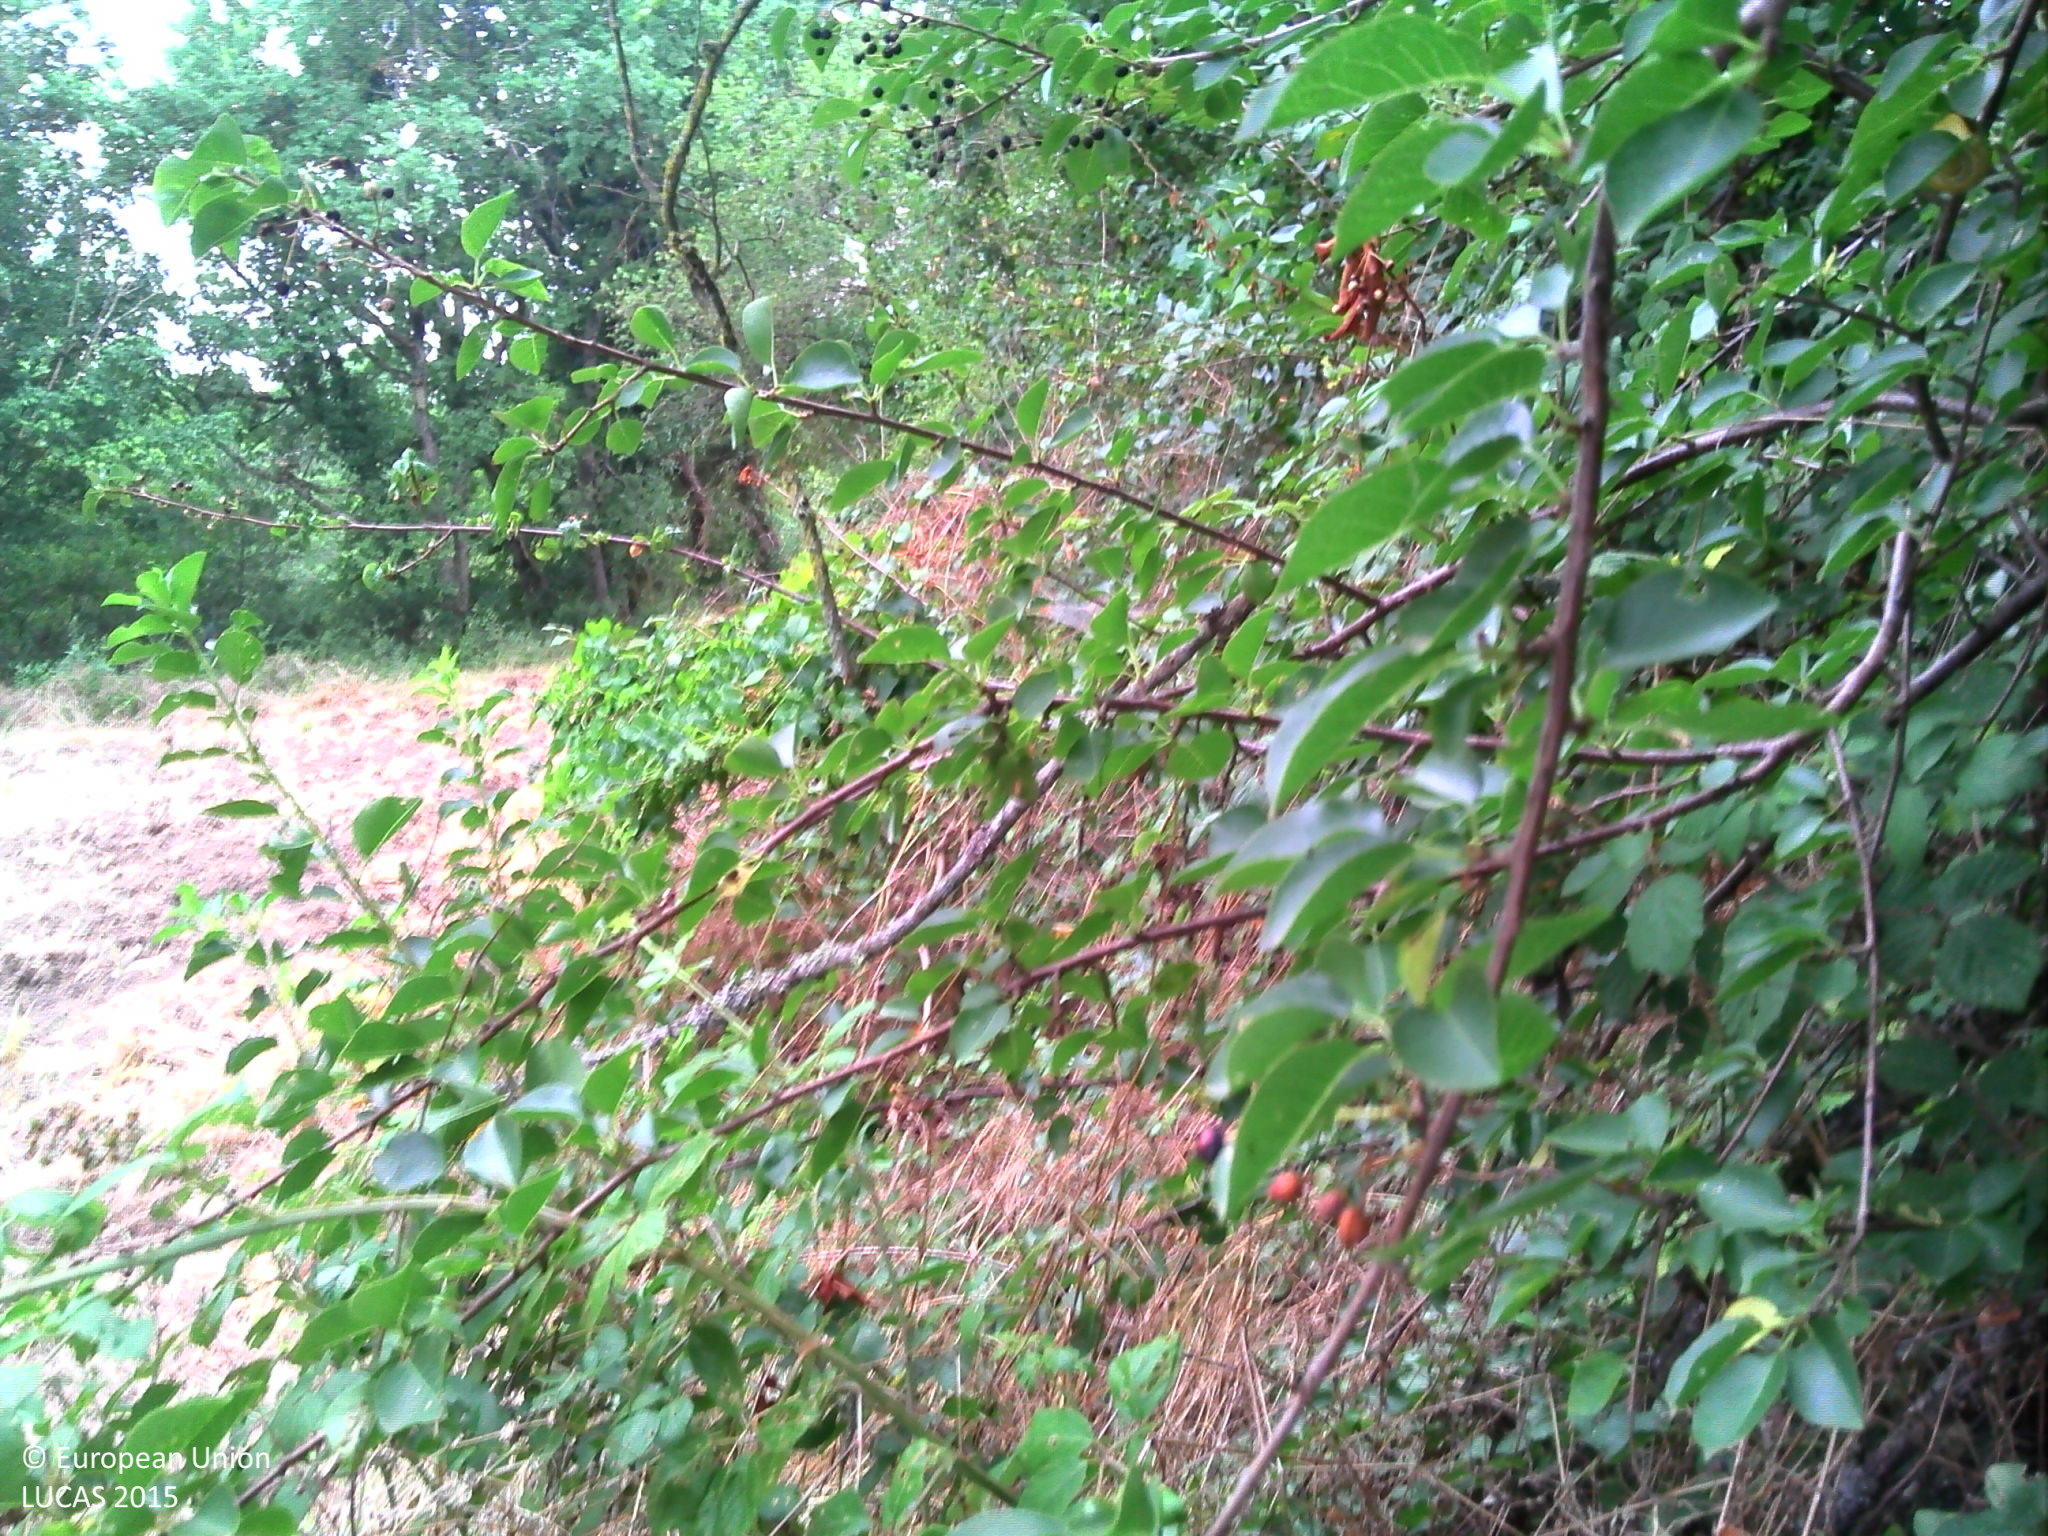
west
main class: Woodland
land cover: Broadleaved woodland
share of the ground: > 75 %
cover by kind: broadleaved forest trees 95 %, shrubs 5 %
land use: Agriculture (excluding fallow land and kitchen gardens)
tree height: > 5 m
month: July
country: FR
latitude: 44.2889
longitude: 0.8348
